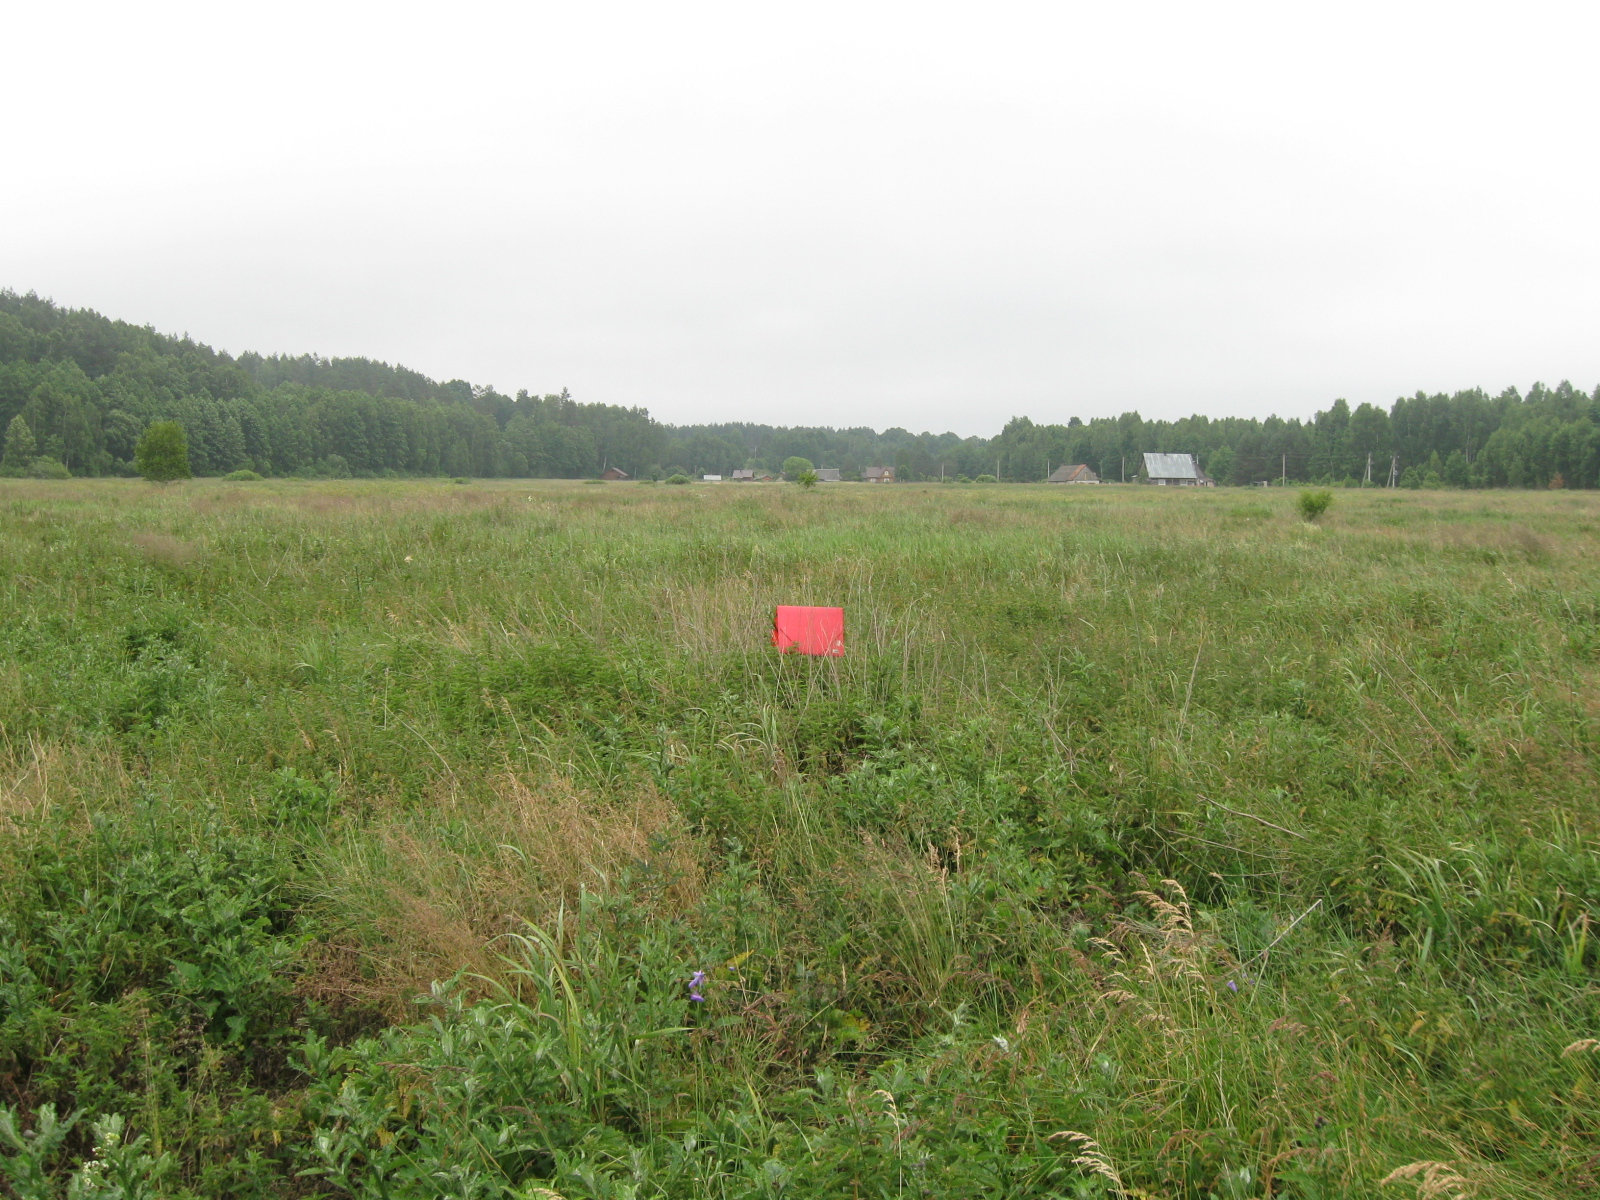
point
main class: Grassland
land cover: Spontaneously vegetated surfaces
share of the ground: > 75 %
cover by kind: herbaceous plants 100 %
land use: Abandoned areas
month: July
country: LT
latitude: 54.0791
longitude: 24.1738
